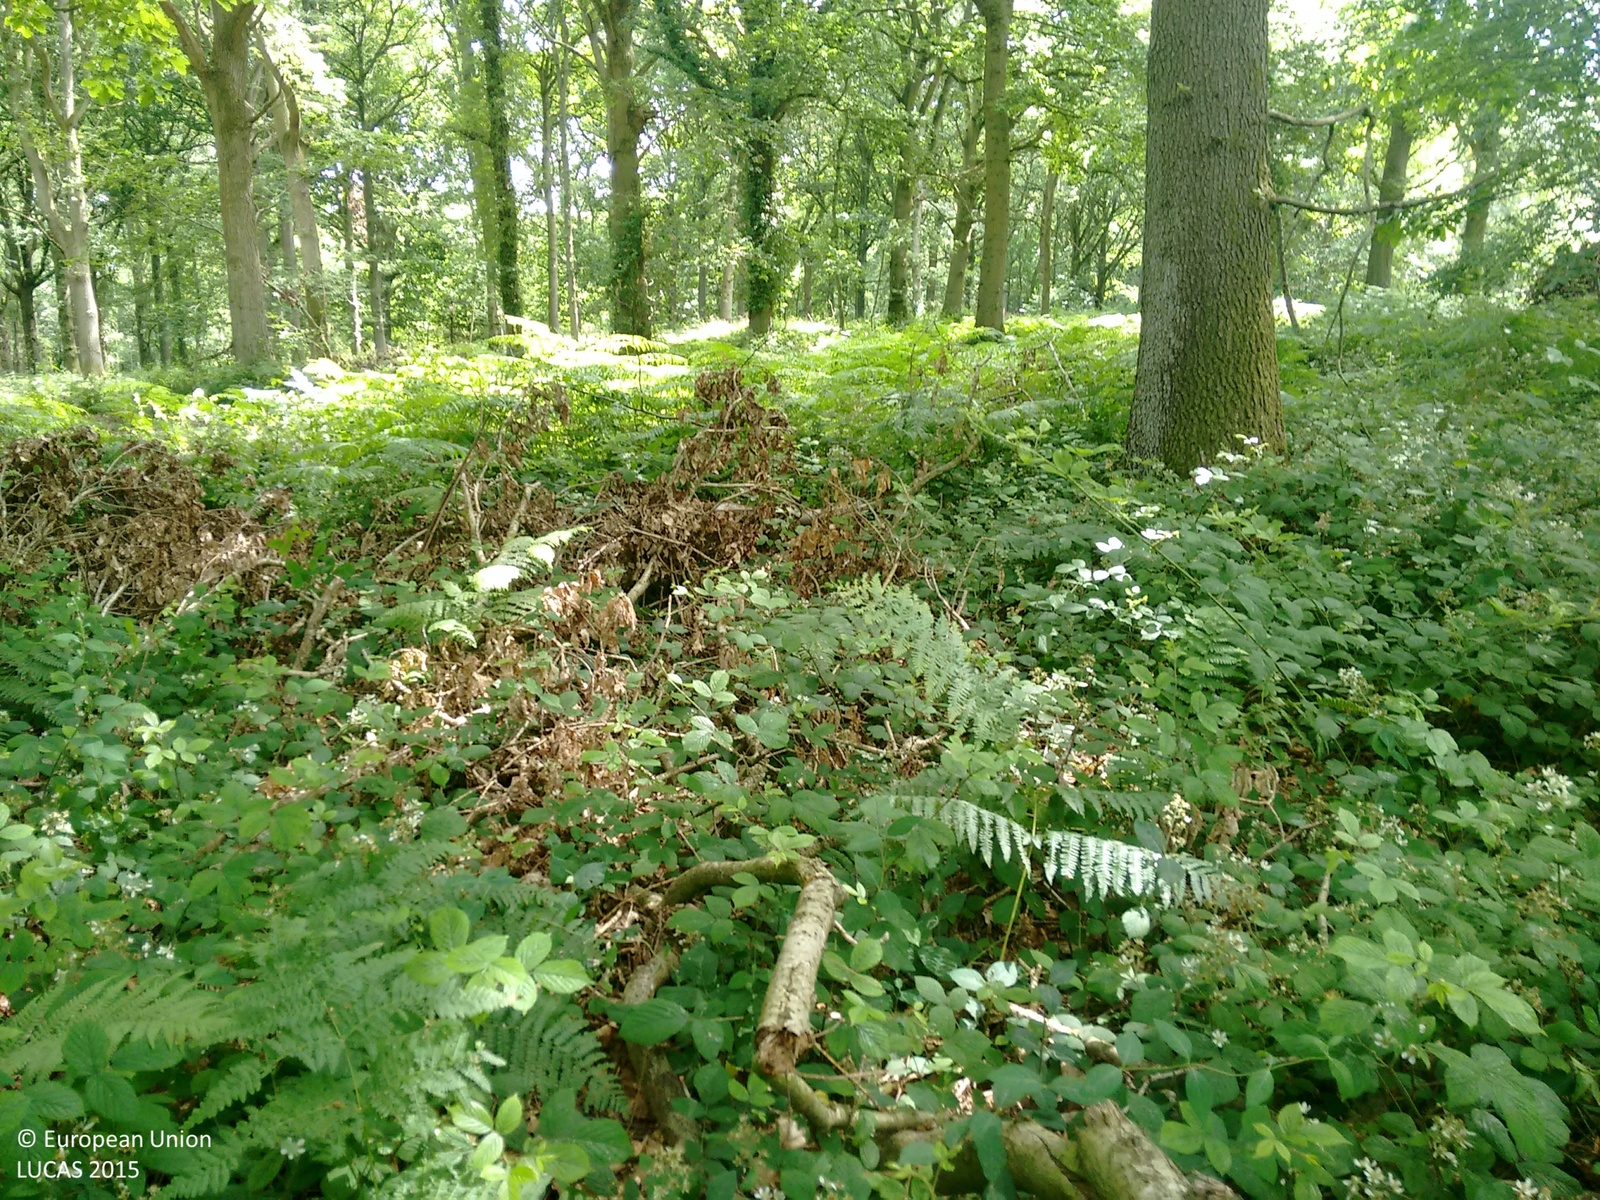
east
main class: Woodland
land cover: Broadleaved woodland
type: mesophytic deciduous forest
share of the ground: > 75 %
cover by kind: broadleaved forest trees 95 %, shrubs 5 %
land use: Semi-natural and natural areas not in use
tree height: > 5 m
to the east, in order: Broadleaved woodland; Ditches and canals; Paved roads, cycling and walking lanes; Broadleaved woodland; Tracks; Broadleaved woodland
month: July
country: GB
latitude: 52.1636
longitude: -2.7157
